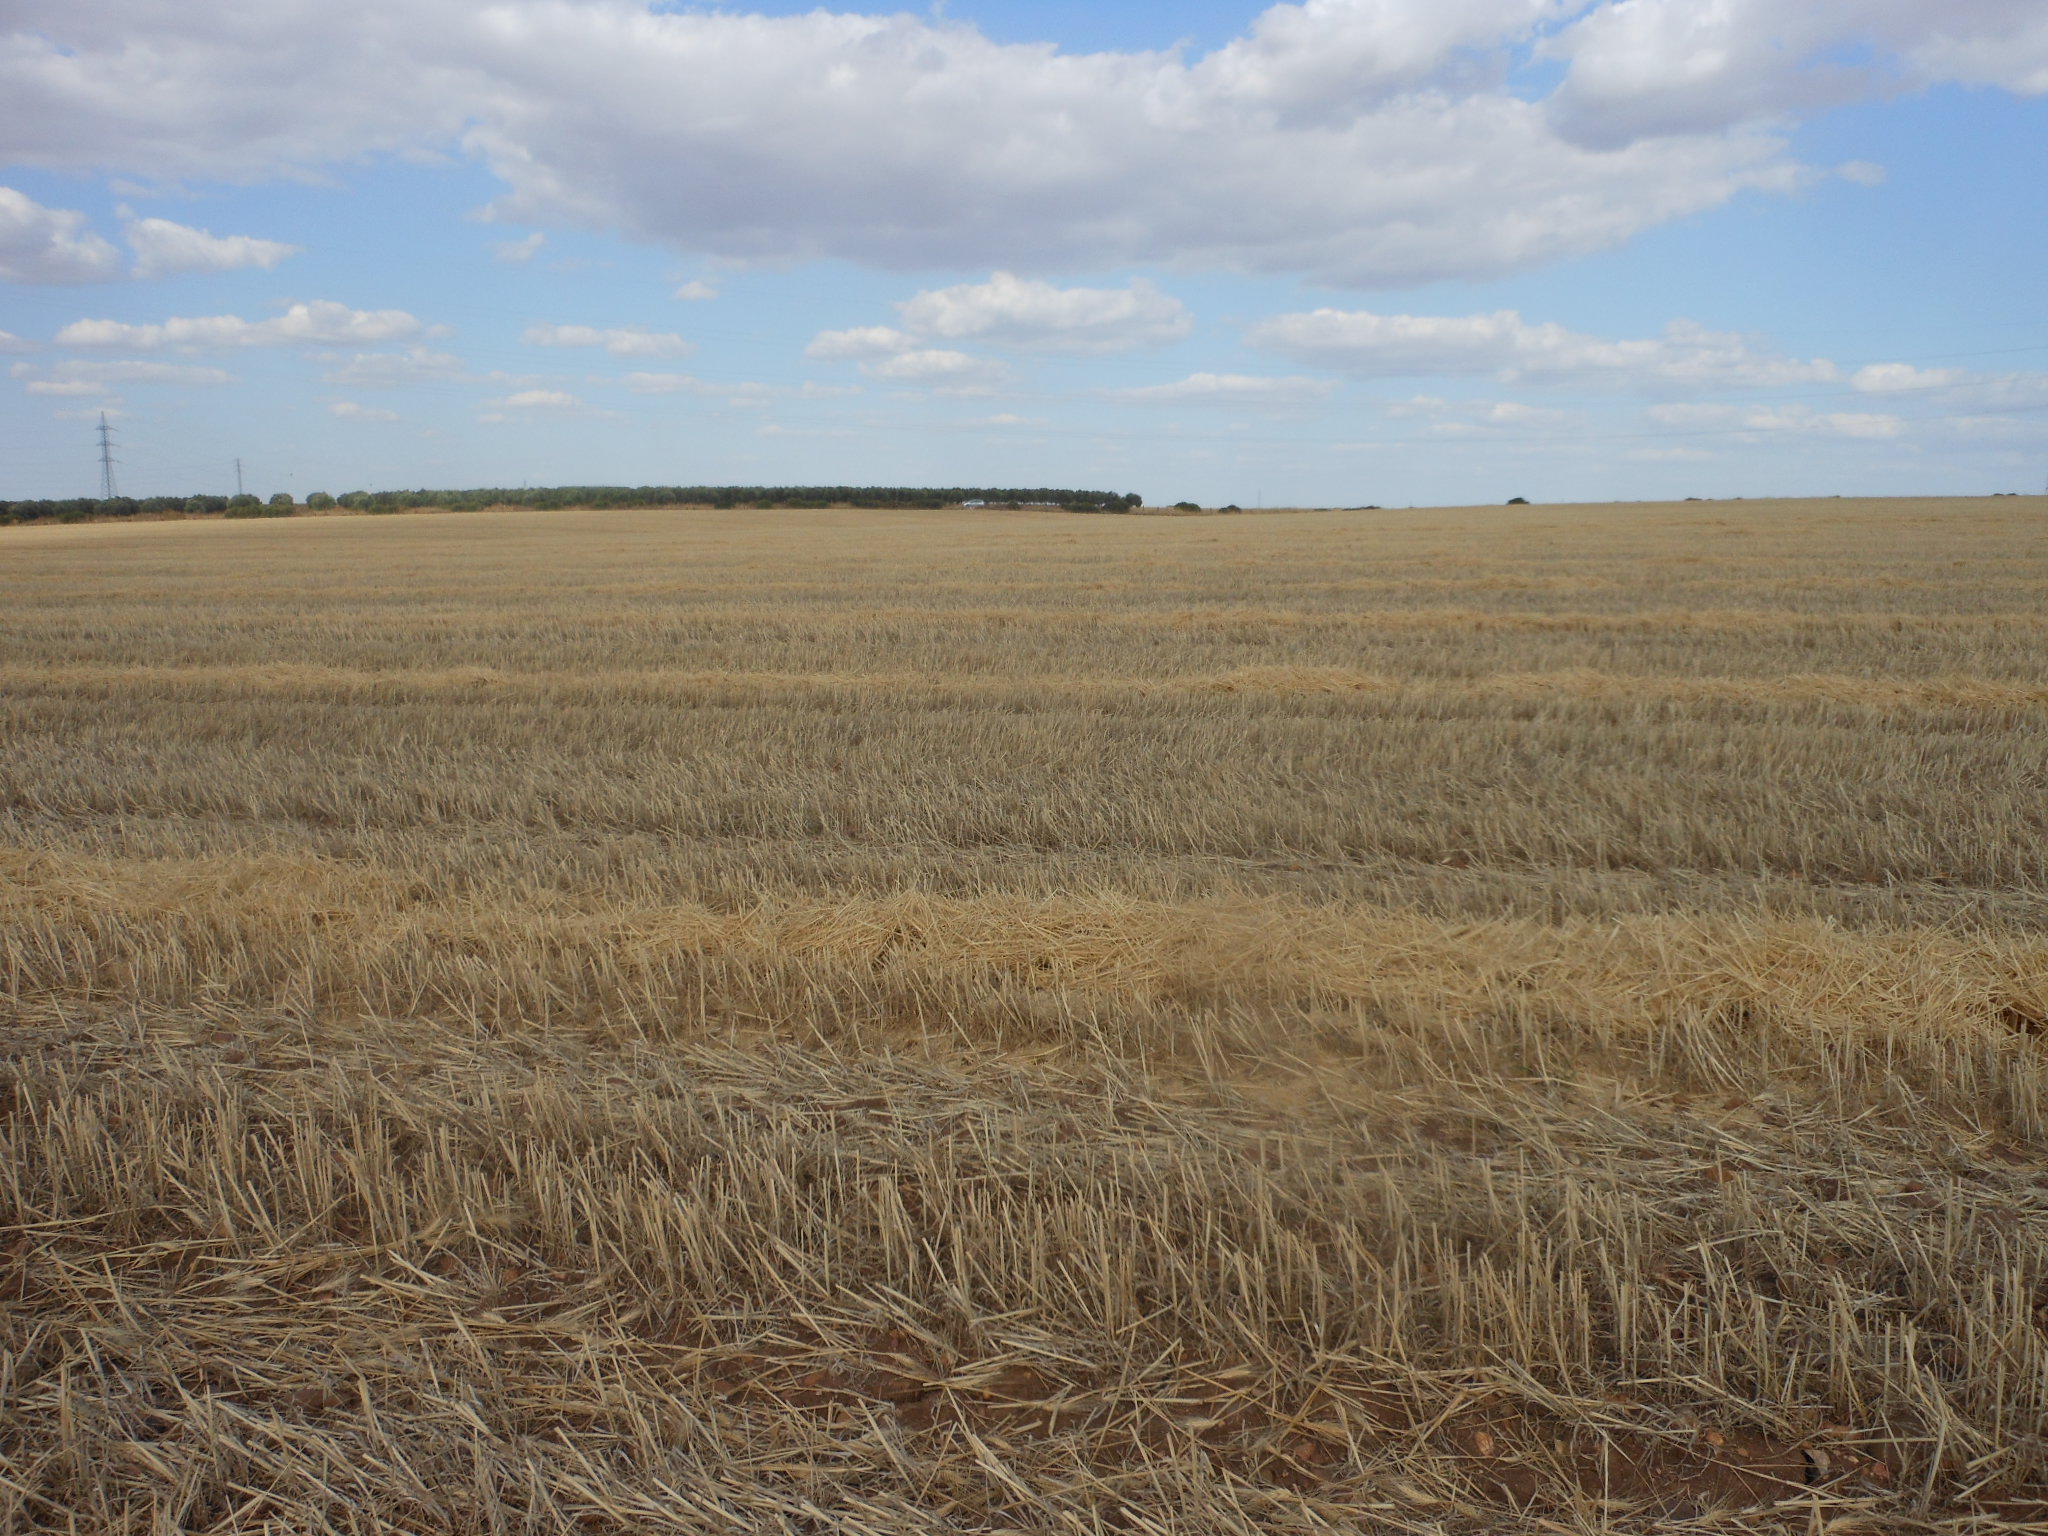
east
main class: Cropland
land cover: Durum wheat
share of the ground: < 10 %
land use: Agriculture (excluding fallow land and kitchen gardens)
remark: Harvested field
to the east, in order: Durum wheat
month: June
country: ES
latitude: 37.6210
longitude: -5.2092
